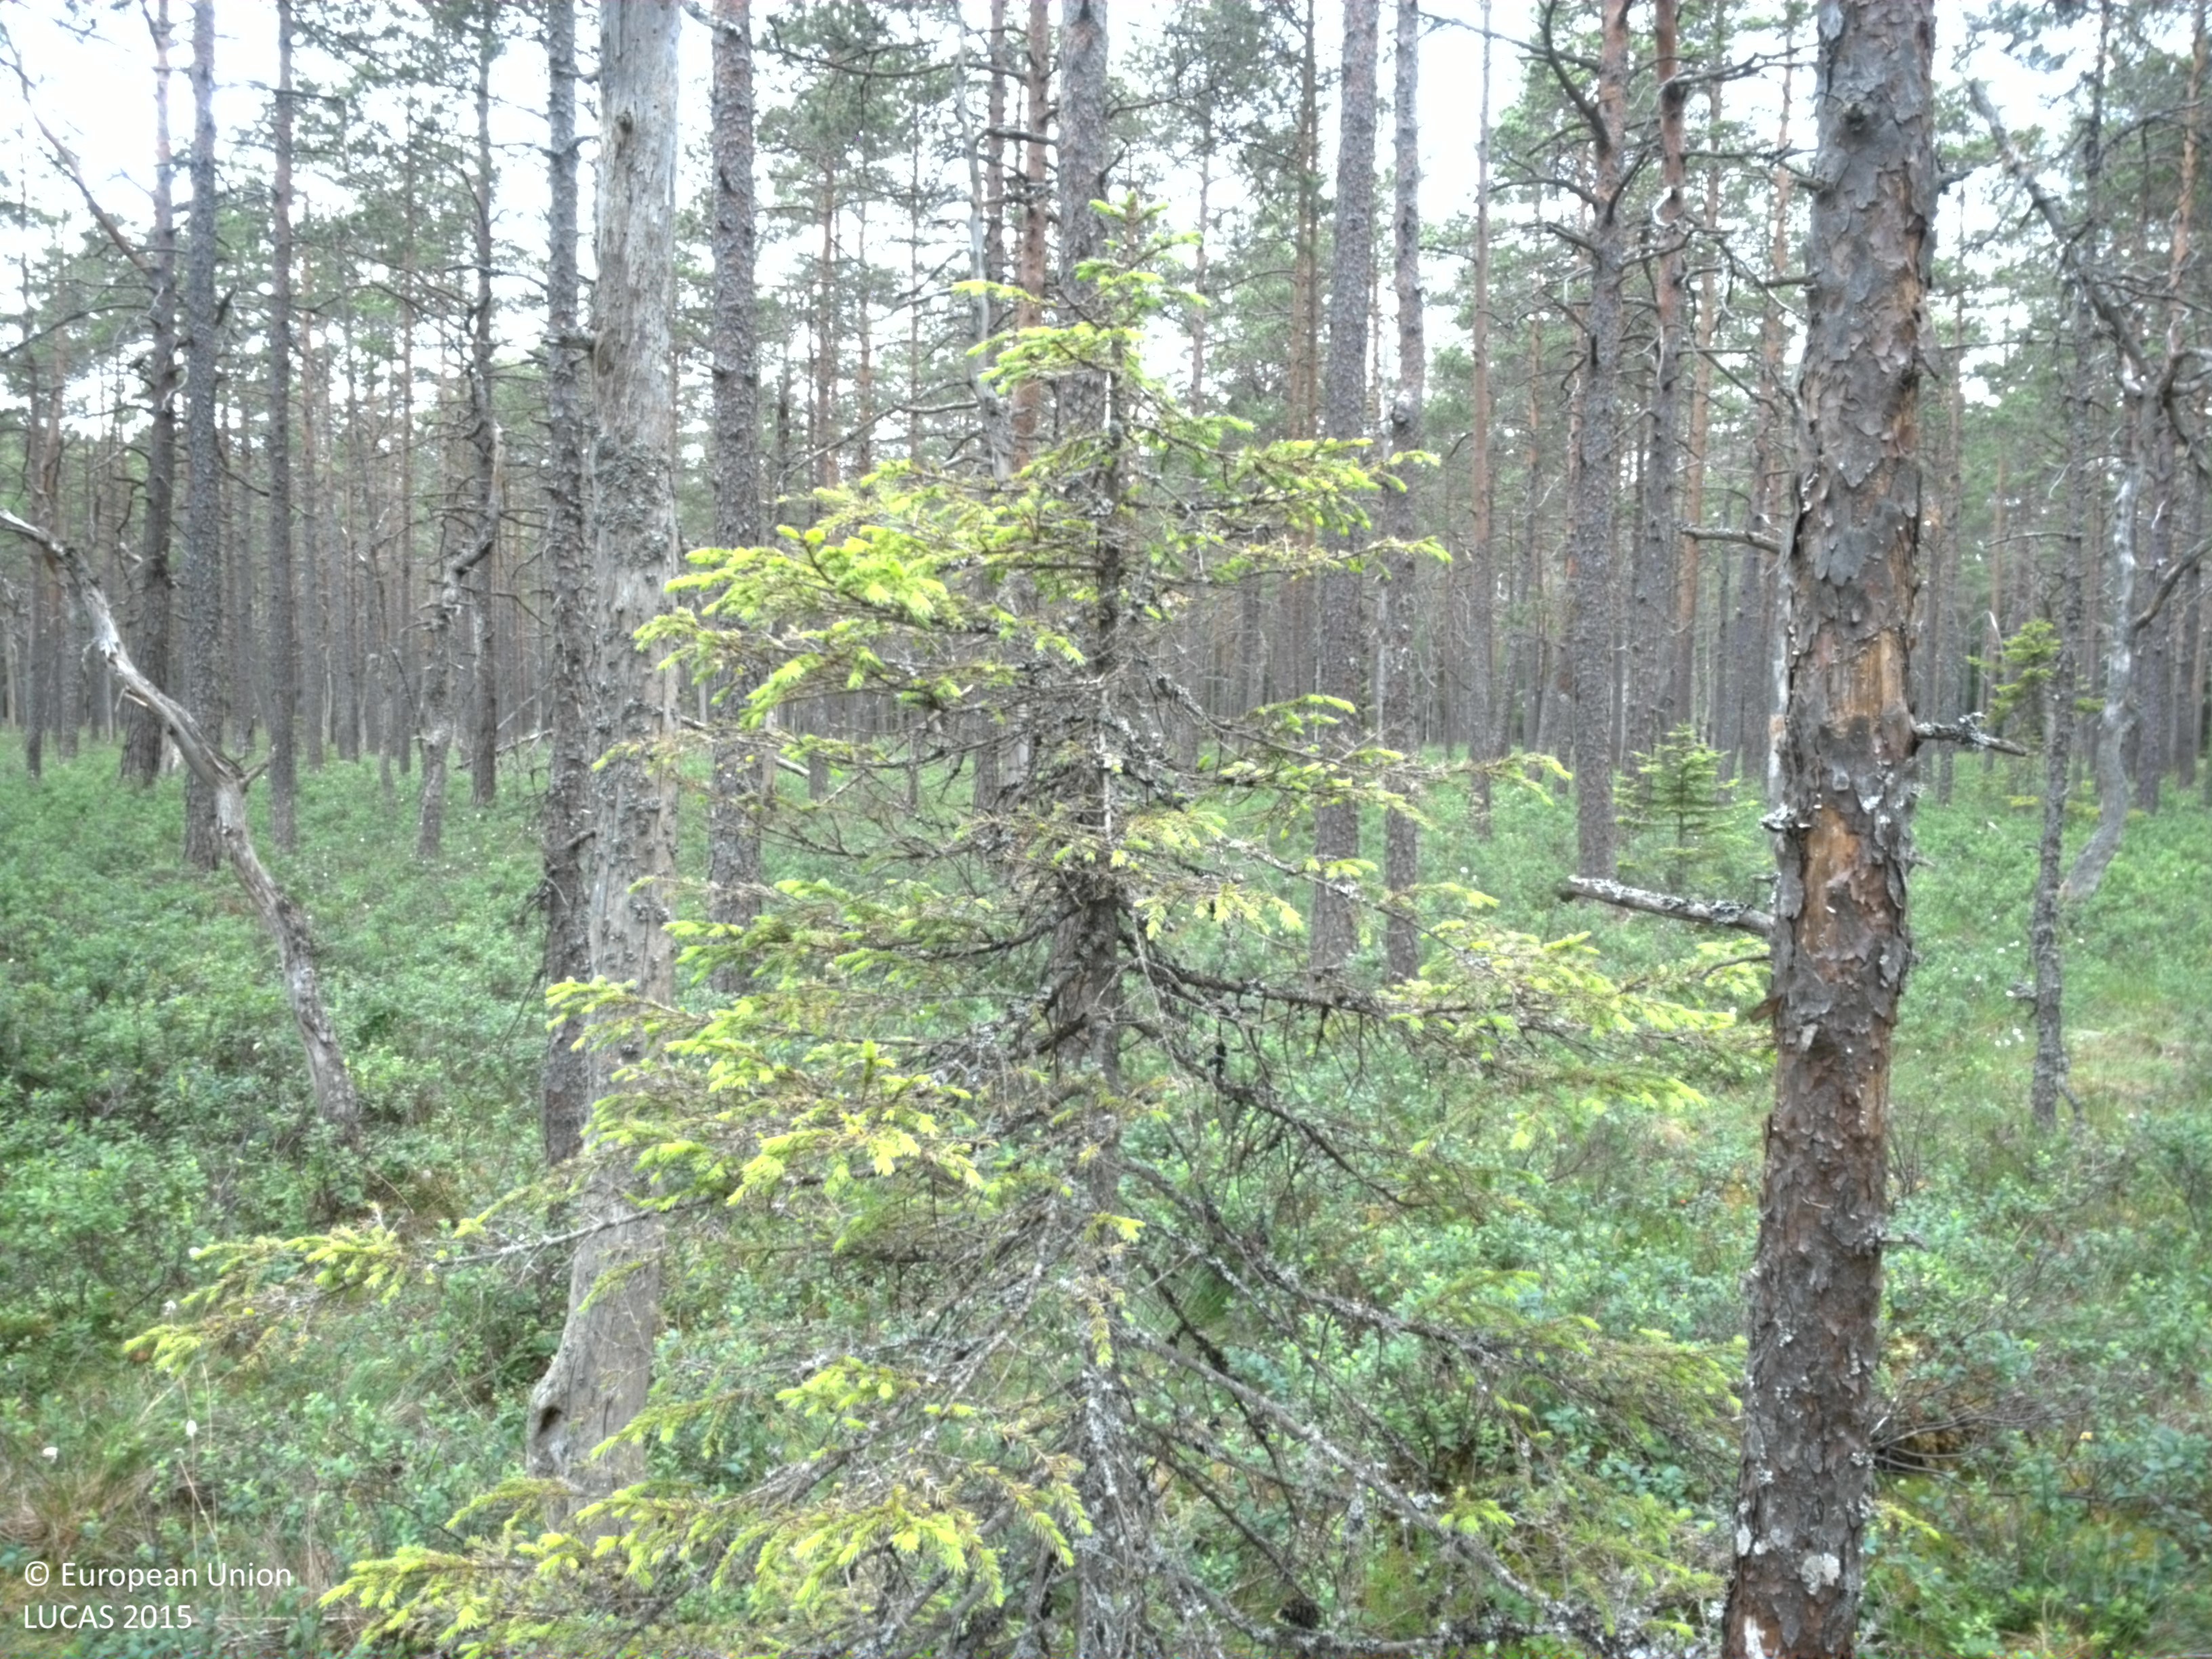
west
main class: Woodland
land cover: Pine dominated coniferous woodland
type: boreal forest
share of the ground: 50 - 75 %
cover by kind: coniferous forest trees 70 %, shrubs 20 %, lichens and mosses 10 %
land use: Forestry
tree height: > 5 m
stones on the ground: < 10 %
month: July
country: SE
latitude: 57.5611
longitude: 14.6926
